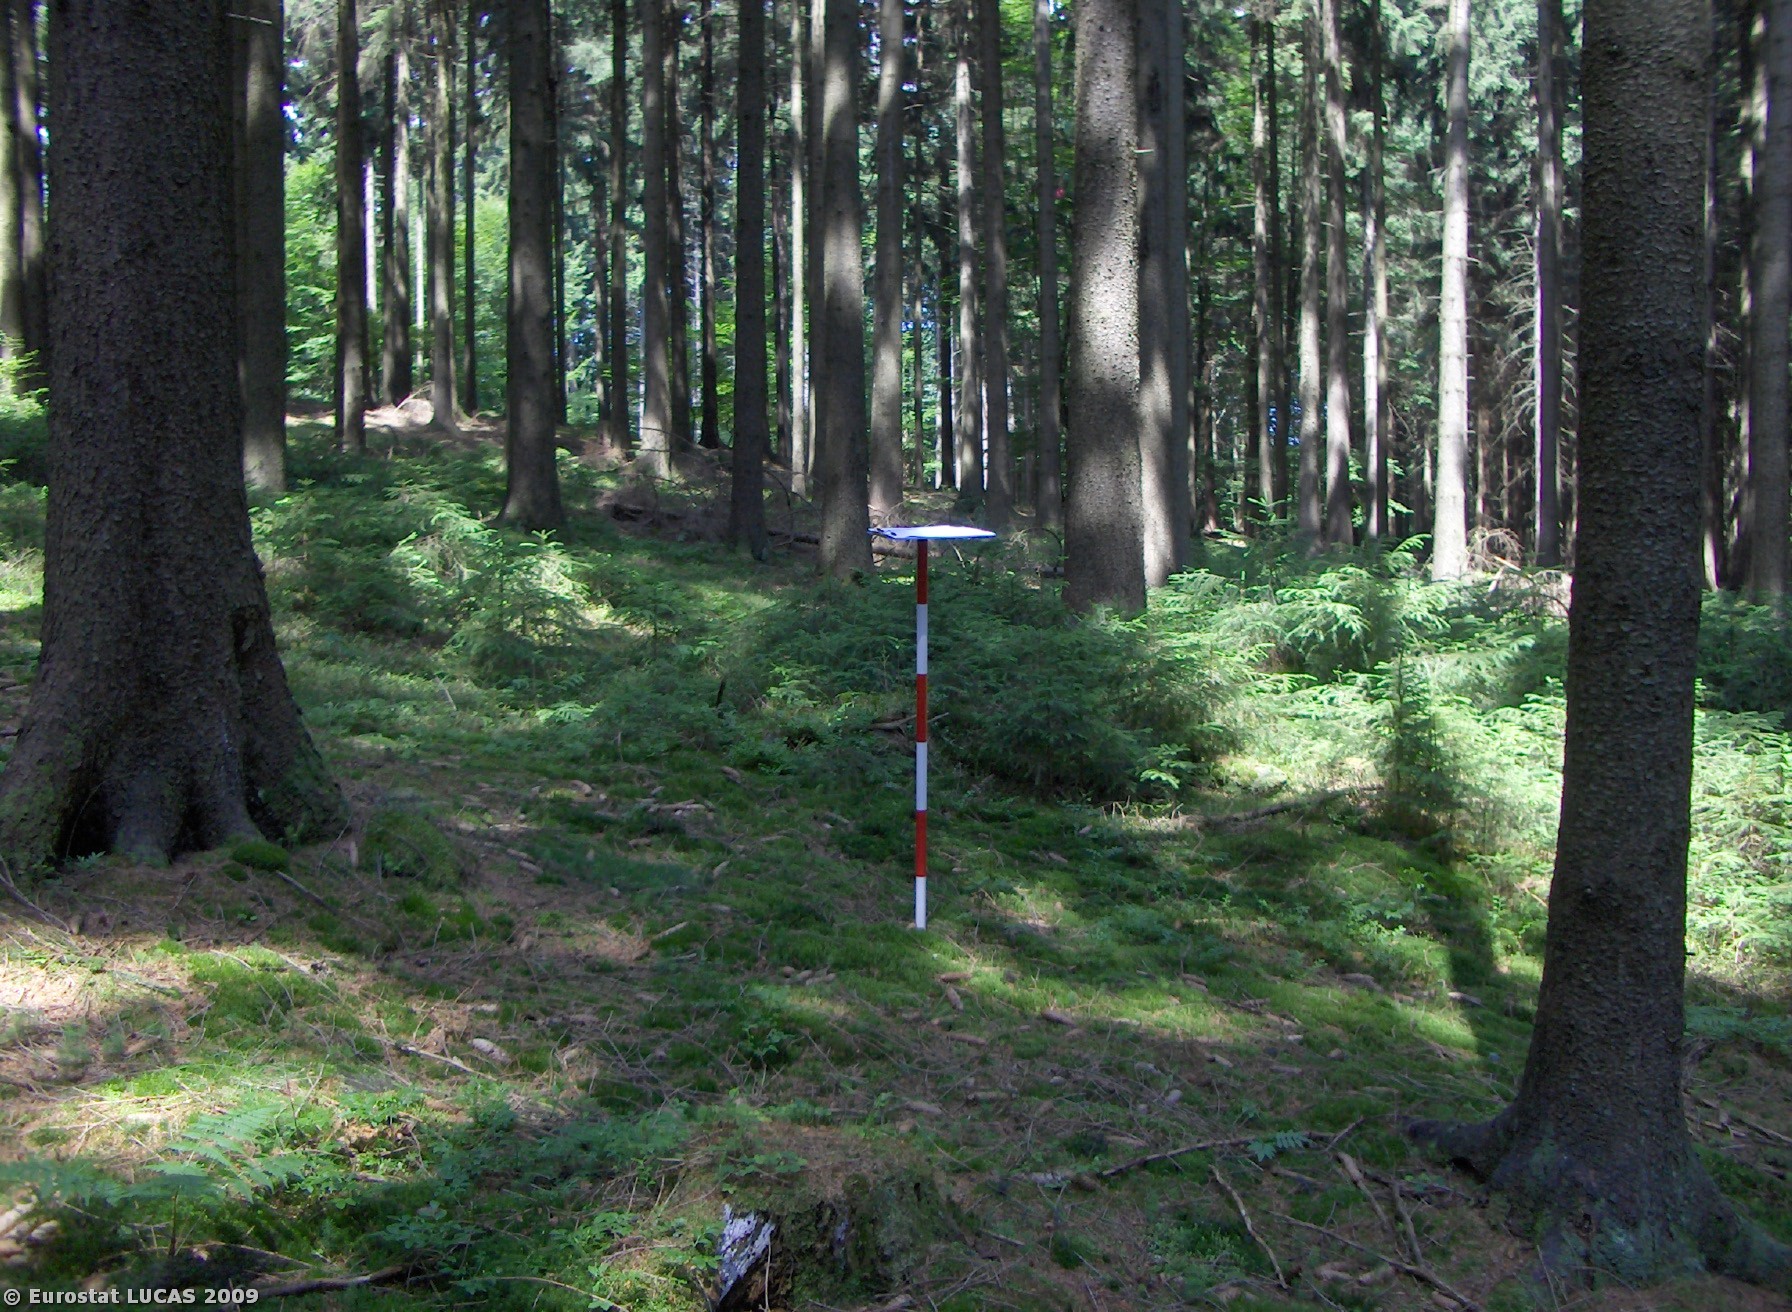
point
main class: Woodland
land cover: Coniferous woodland
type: hemiboreal forest and nemoral coniferous forest and mixed broadleaved-coniferous forest
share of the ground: > 75 %
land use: Forestry
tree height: > 5 m
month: July
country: CZ
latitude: 49.4694
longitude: 12.6629
